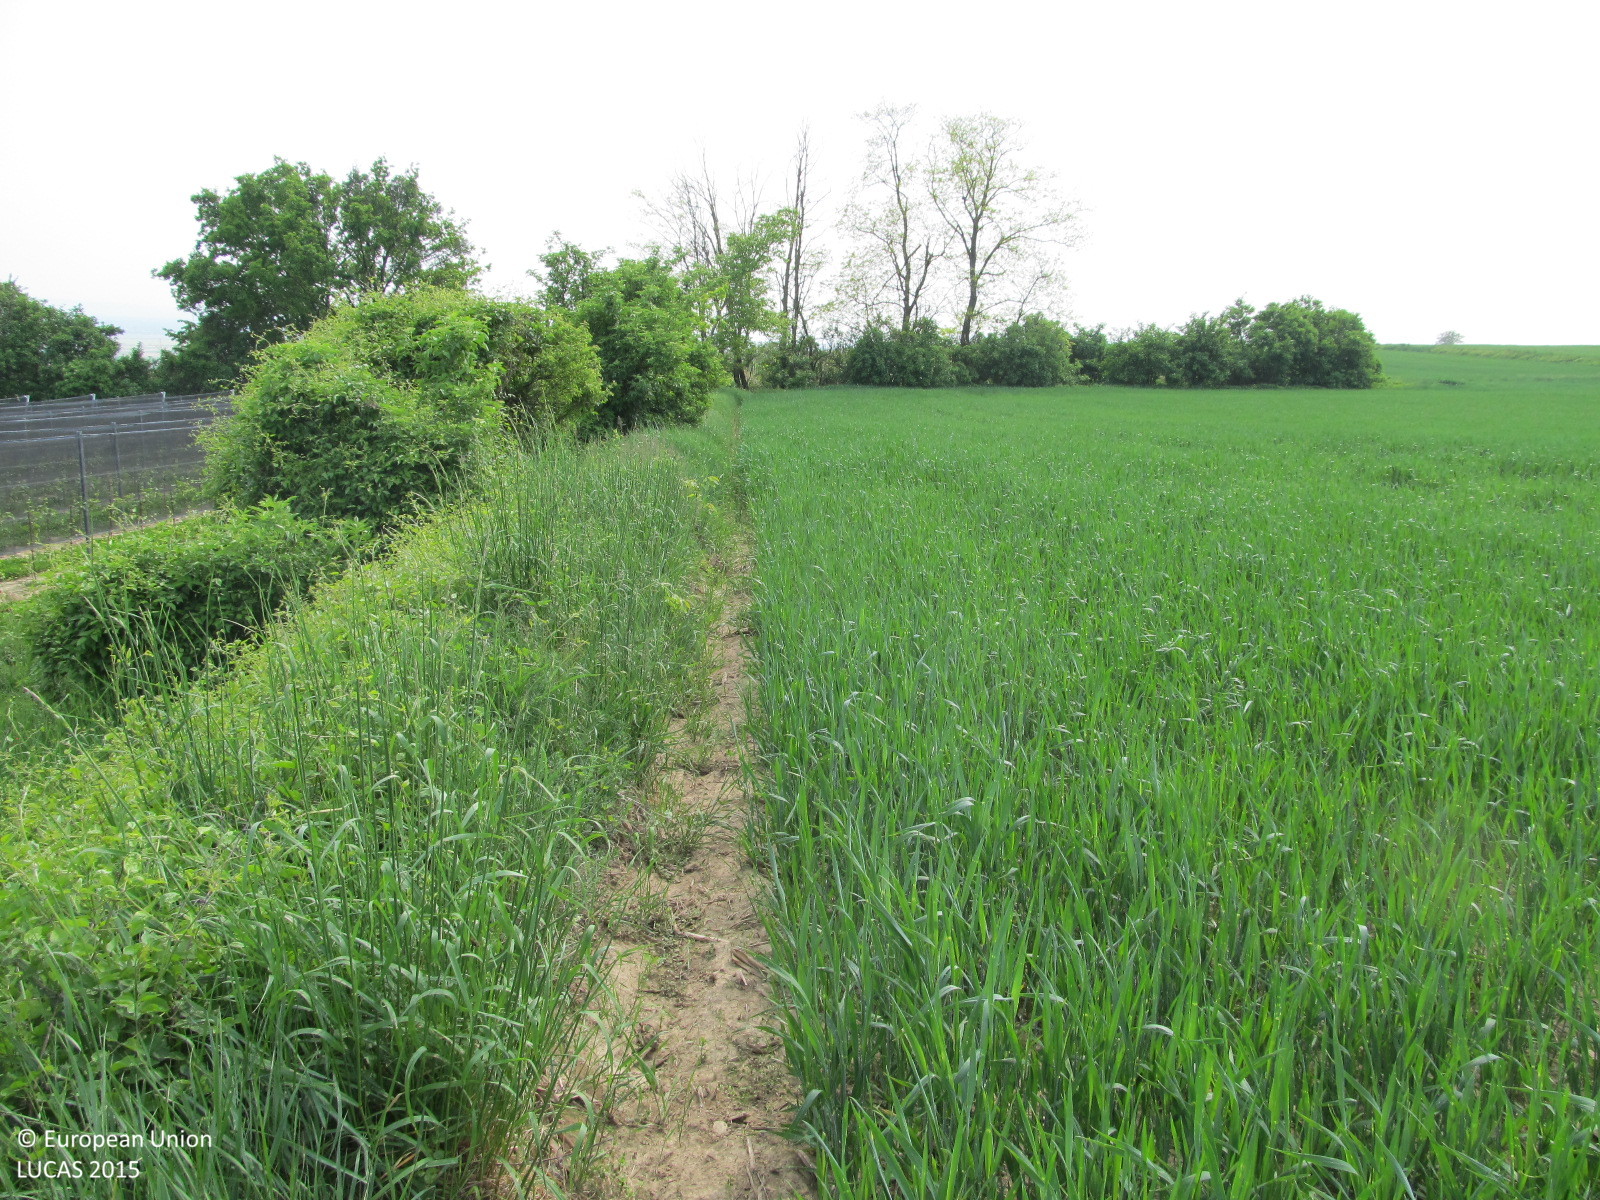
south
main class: Cropland
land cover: Vineyards
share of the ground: 25 - 50 %
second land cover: Grassland without tree/shrub cover
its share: 25 - 50 %
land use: Agriculture (excluding fallow land and kitchen gardens)
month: May
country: AT
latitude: 48.4674
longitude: 15.8058
